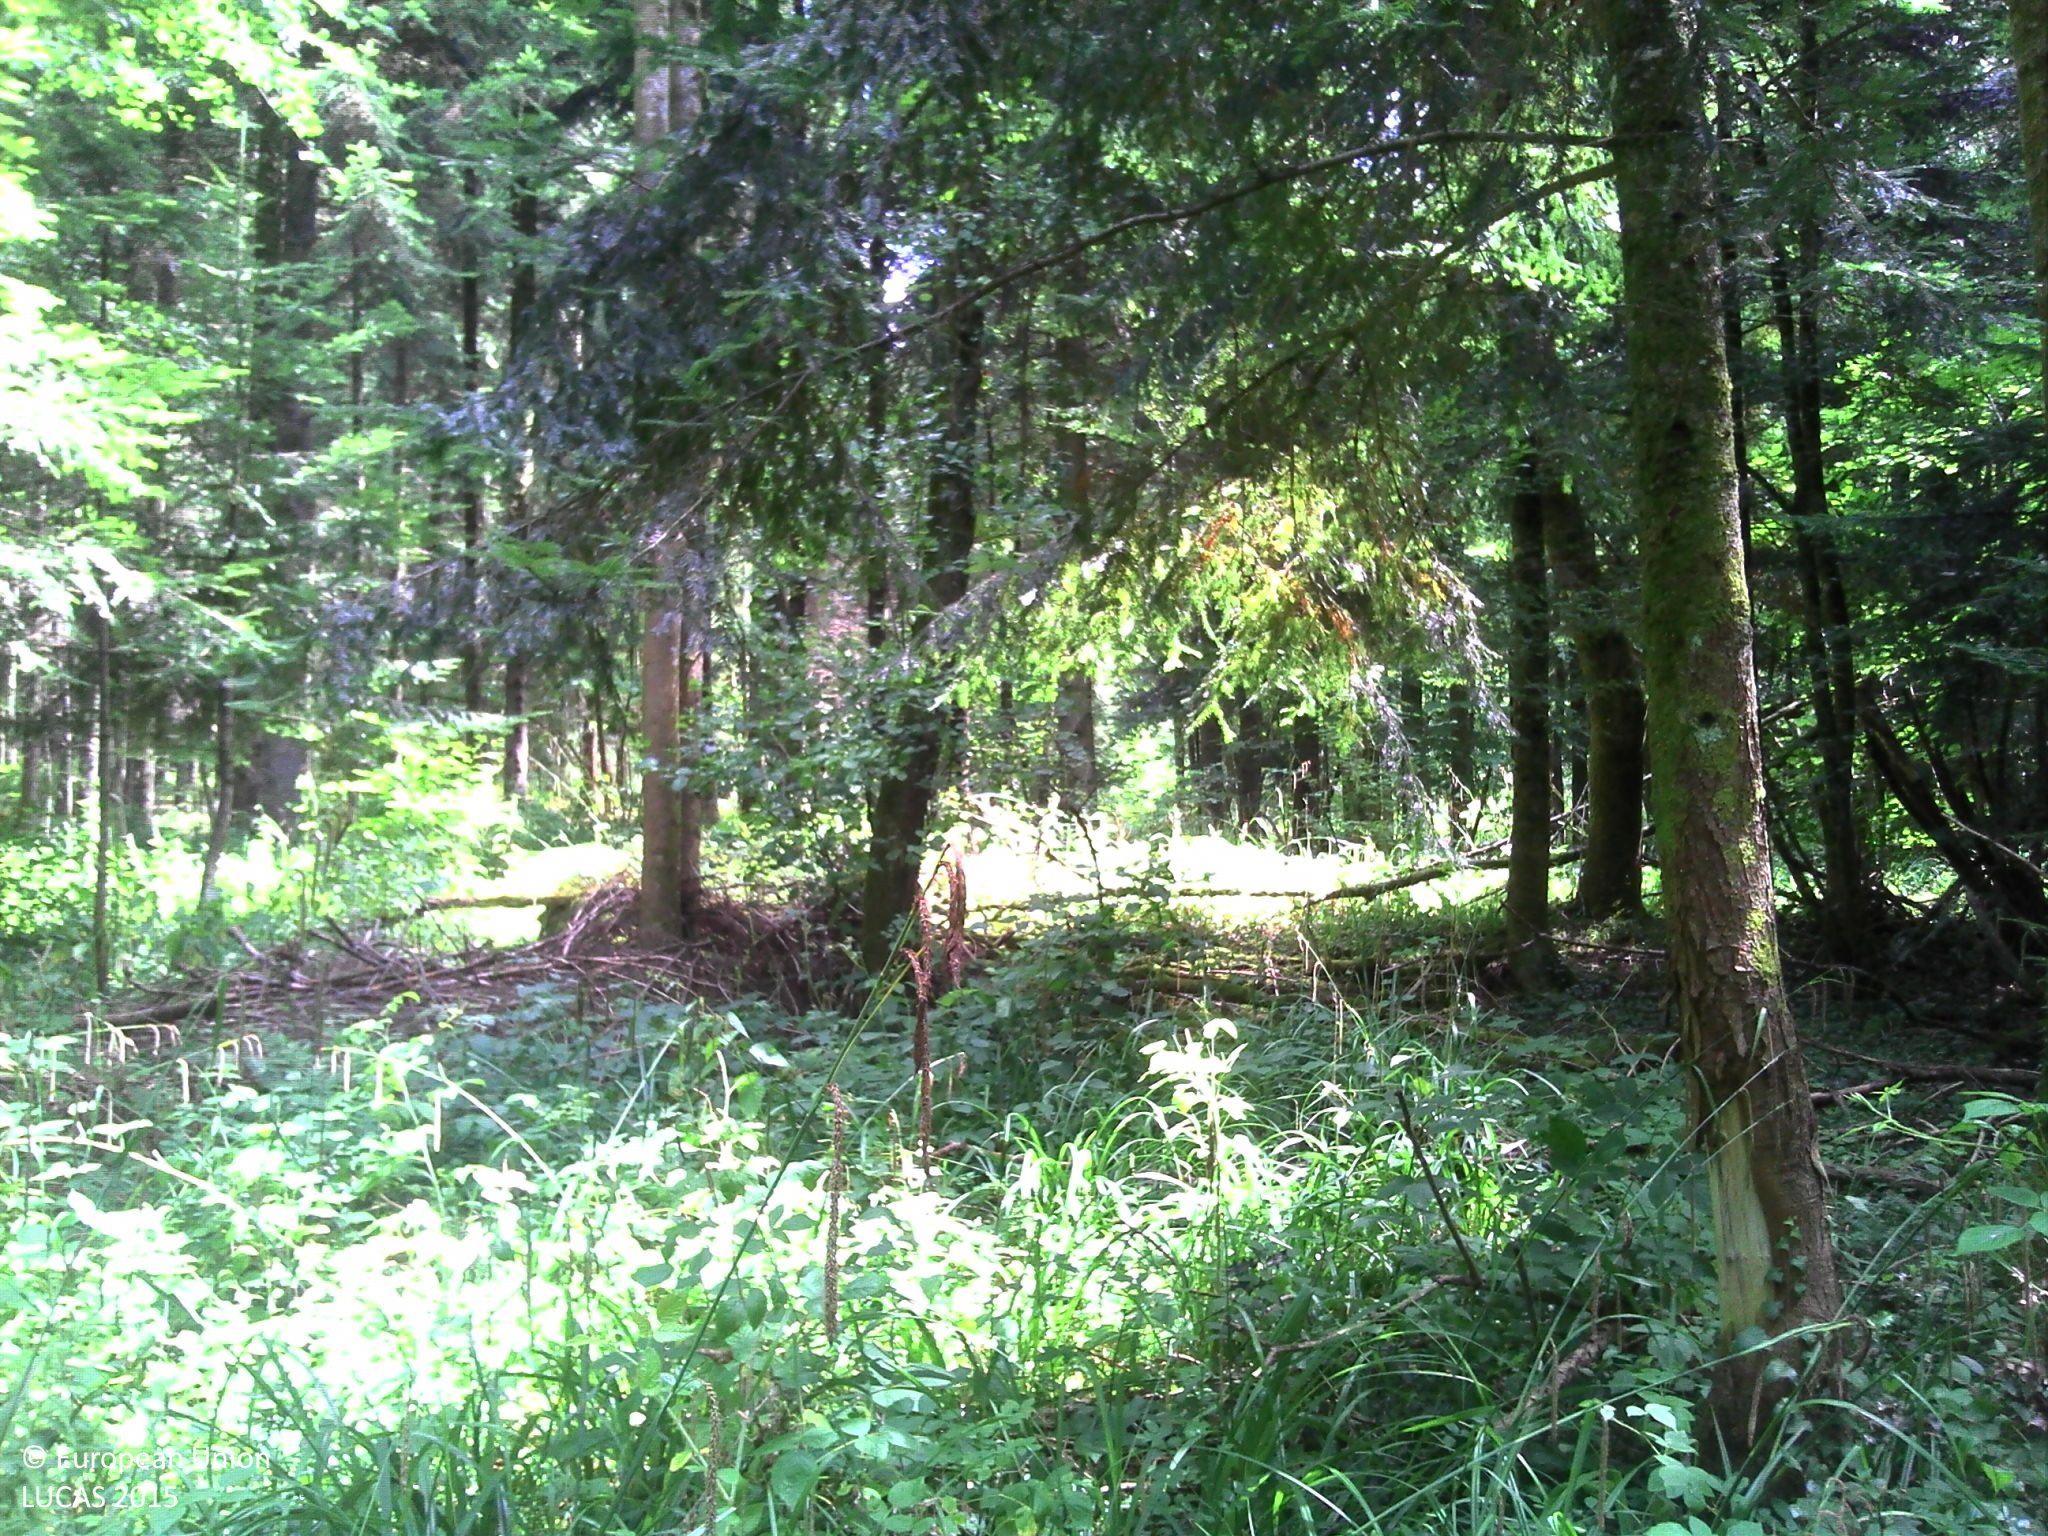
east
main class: Woodland
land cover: Broadleaved woodland
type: mesophytic deciduous forest
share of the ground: > 75 %
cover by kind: broadleaved forest trees 95 %, herbaceous plants 5 %
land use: Forestry
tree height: > 5 m
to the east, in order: Broadleaved woodland; Spruce dominated coniferous woodland; Tracks; Spruce dominated coniferous woodland; Spruce dominated mixed woodland; Spruce dominated coniferous woodland; Broadleaved woodland
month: July
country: FR
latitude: 49.1781
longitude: 5.1007
